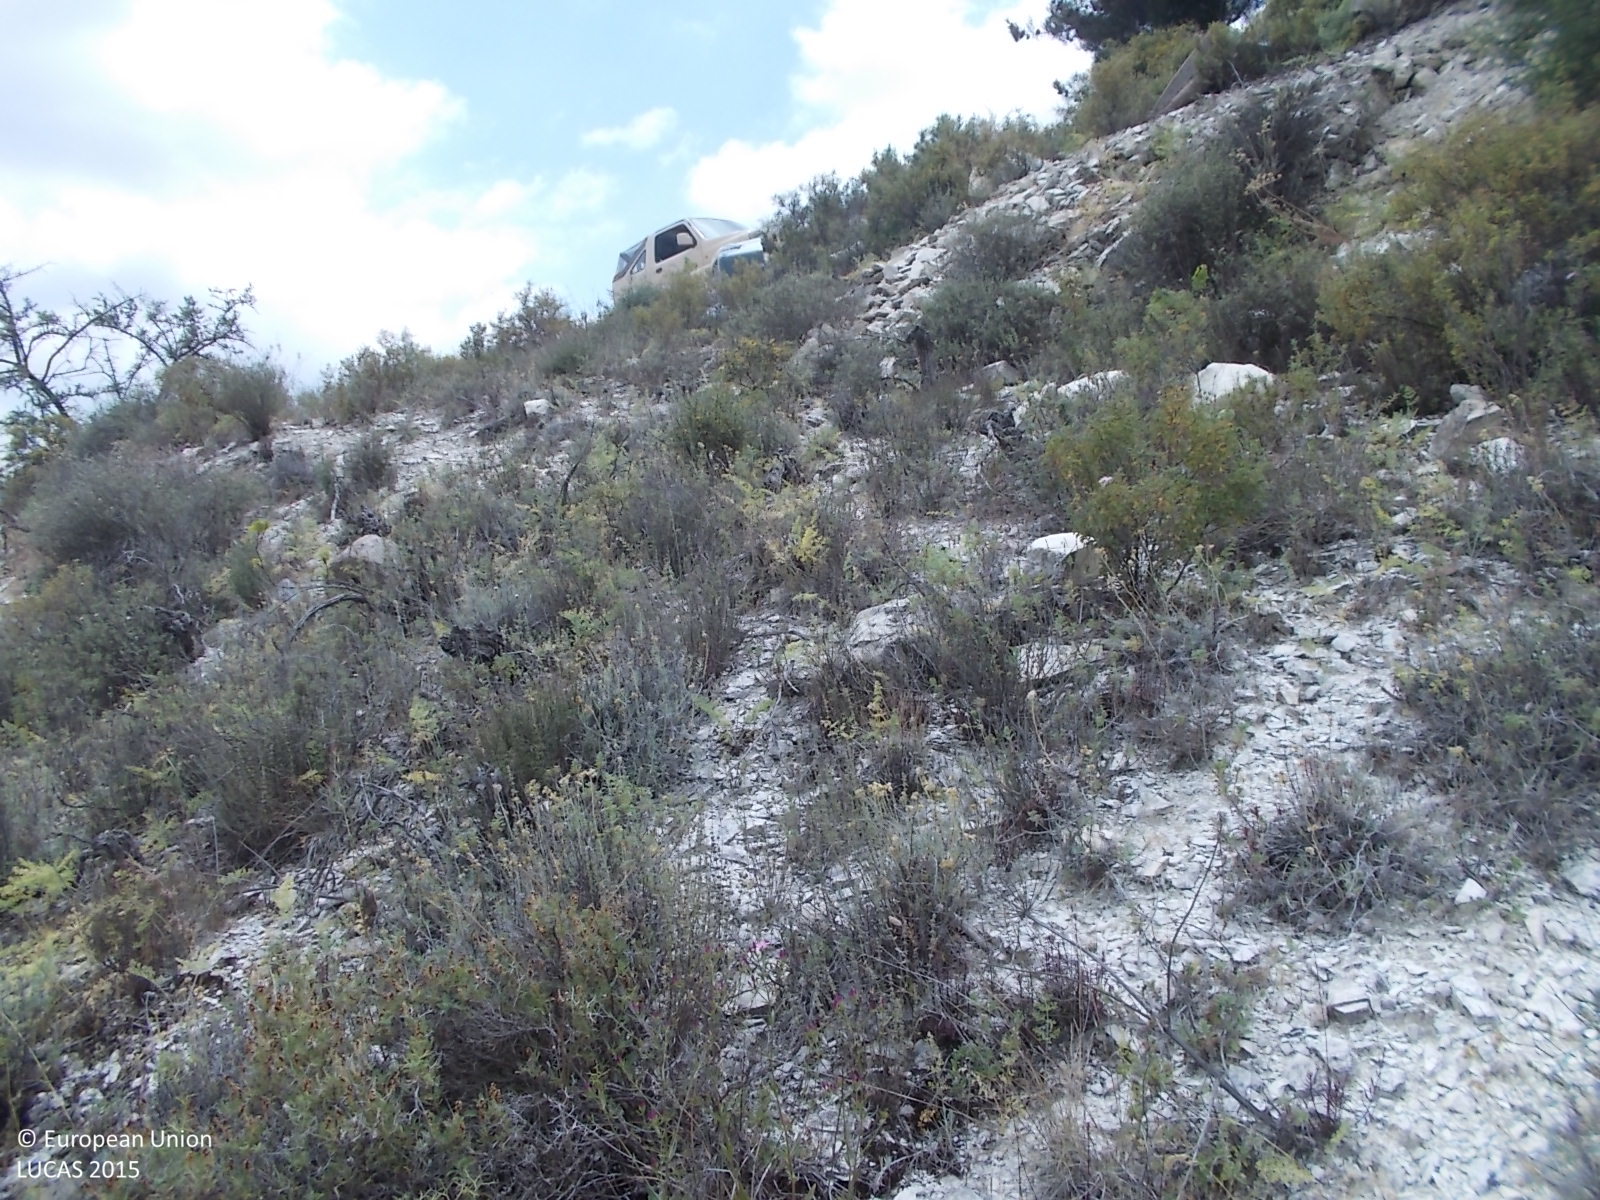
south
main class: Shrubland
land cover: Shrubland without tree cover
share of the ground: 50 - 75 %
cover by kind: shrubs 75 %, consolidated bare surface 15 %, unconsolidated bare surface 10 %
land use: Semi-natural and natural areas not in use
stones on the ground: 25 - 50 %
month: June
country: CY
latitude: 34.8598
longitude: 32.8149
